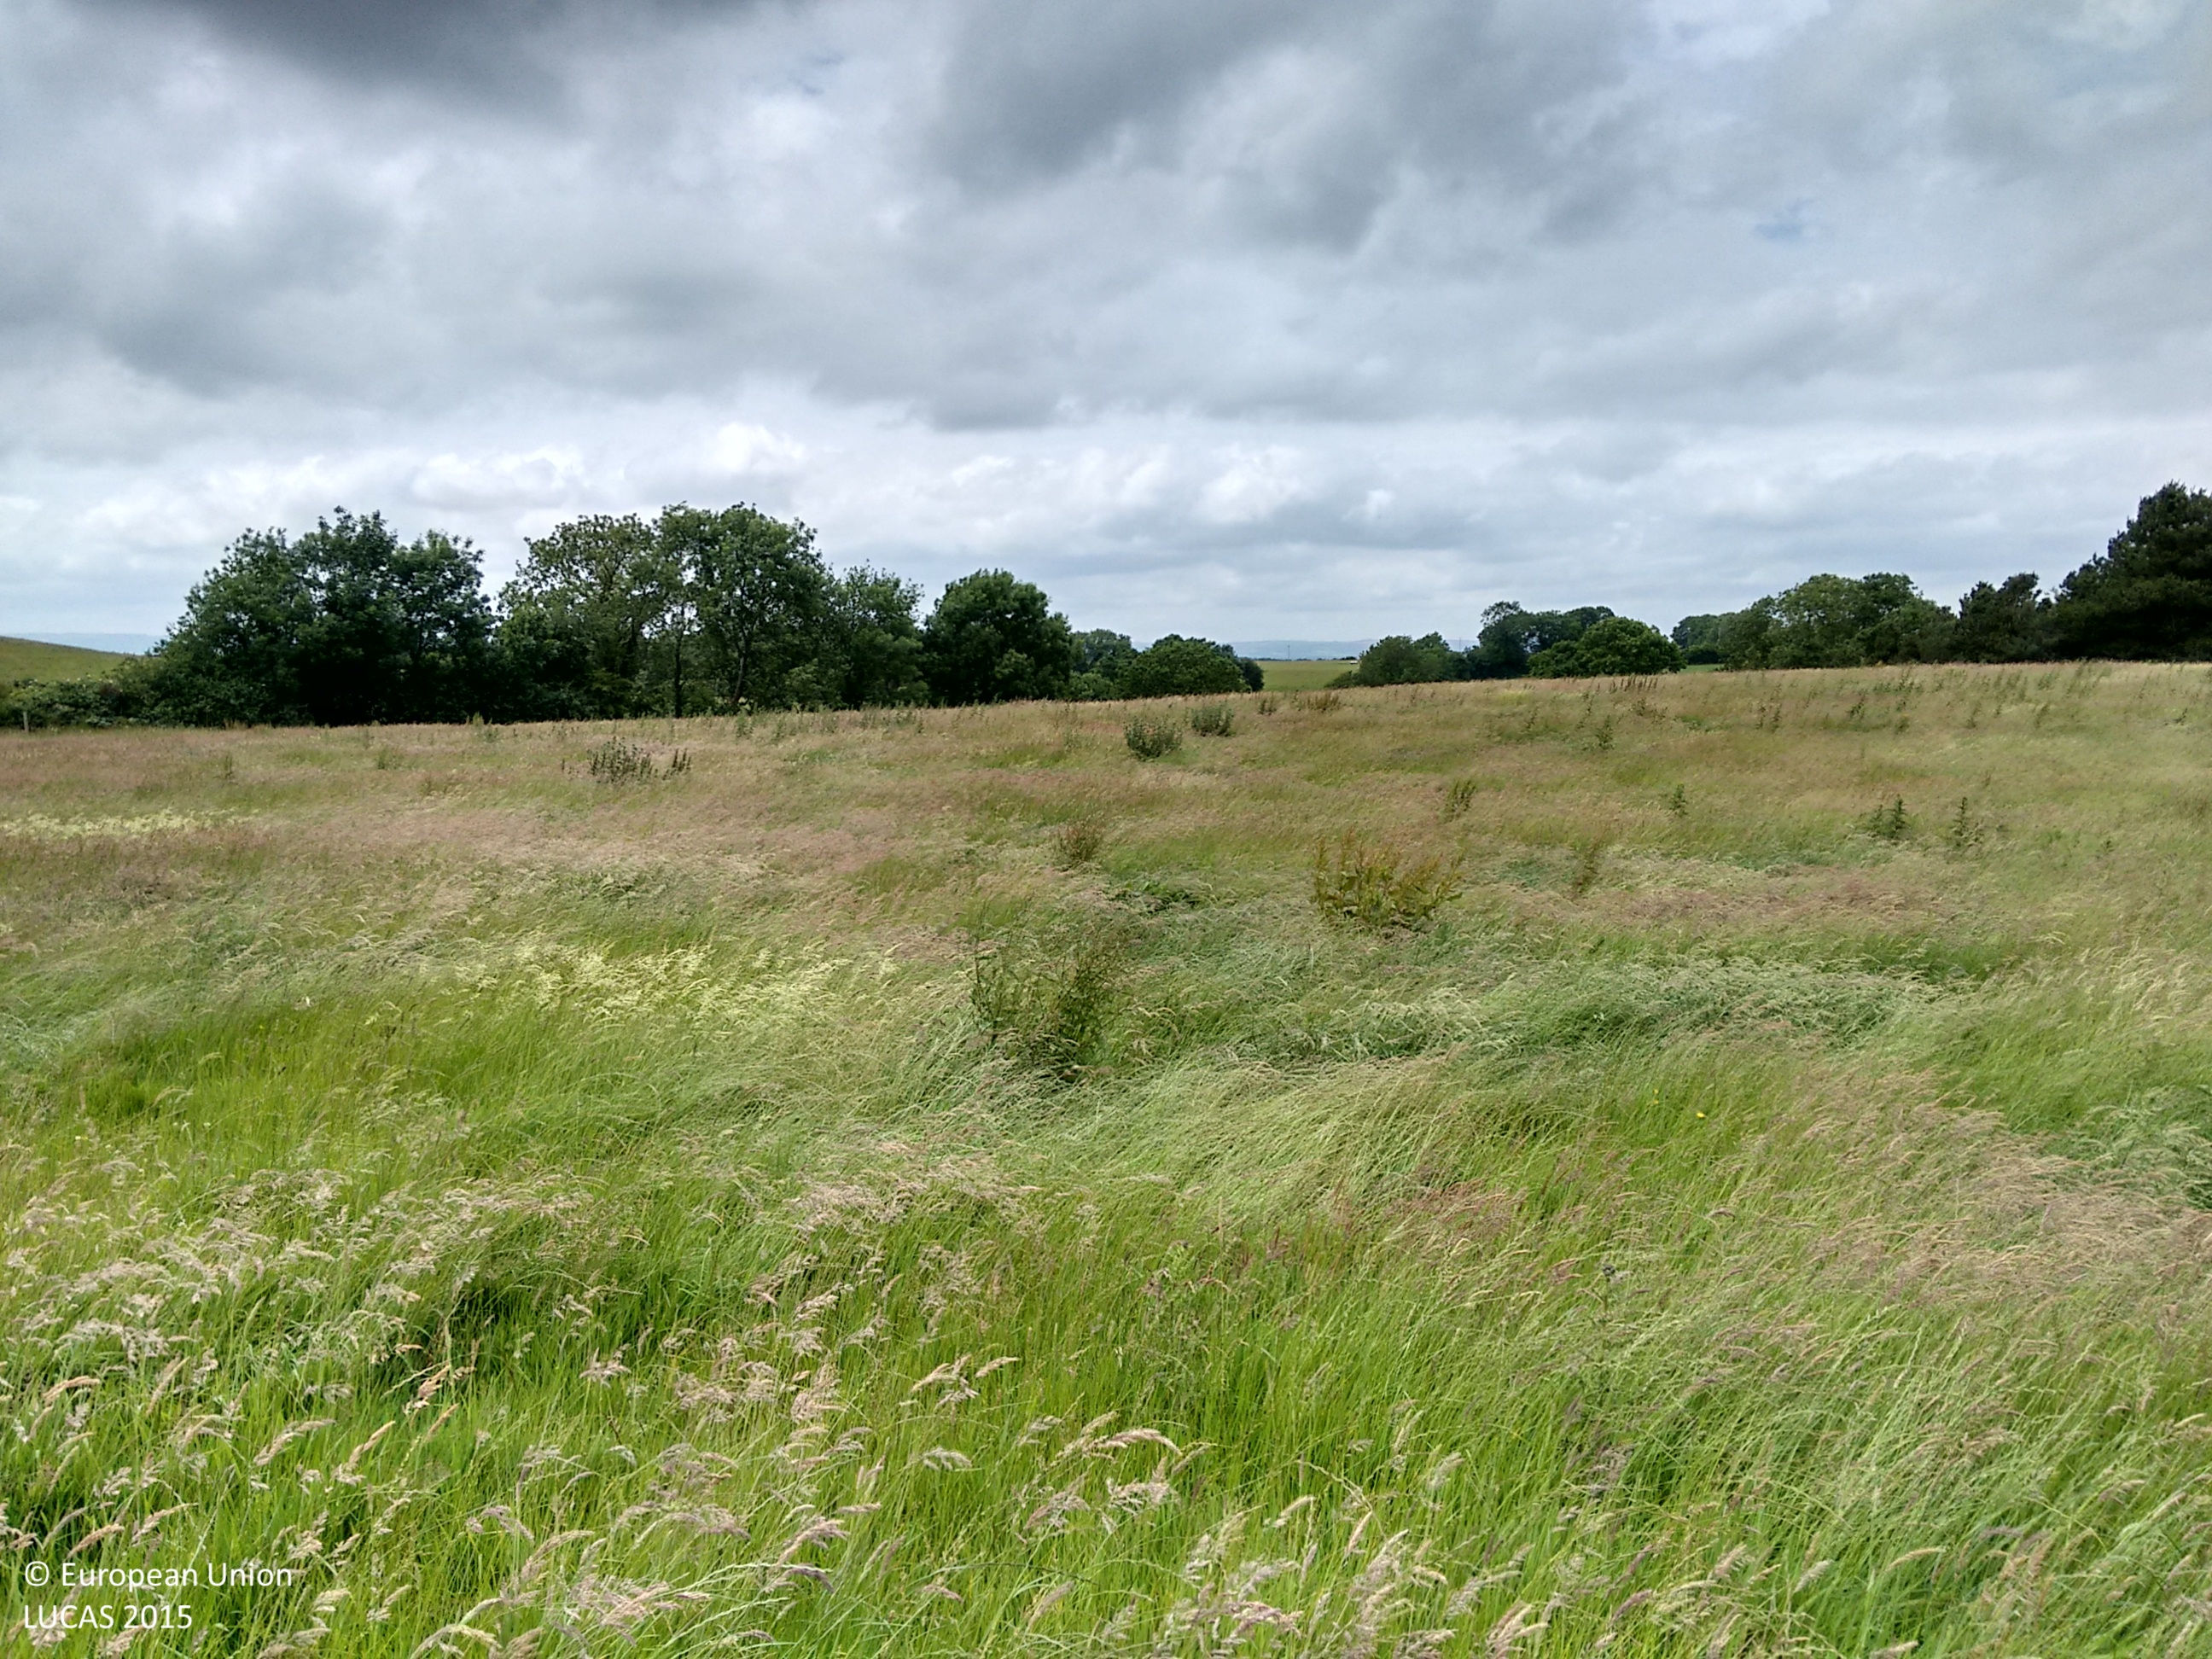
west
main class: Grassland
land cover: Grassland without tree/shrub cover
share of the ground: > 75 %
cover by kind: herbaceous plants 100 %
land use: Agriculture (excluding fallow land and kitchen gardens)
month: July
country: IE
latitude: 52.9484
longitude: -6.8207
